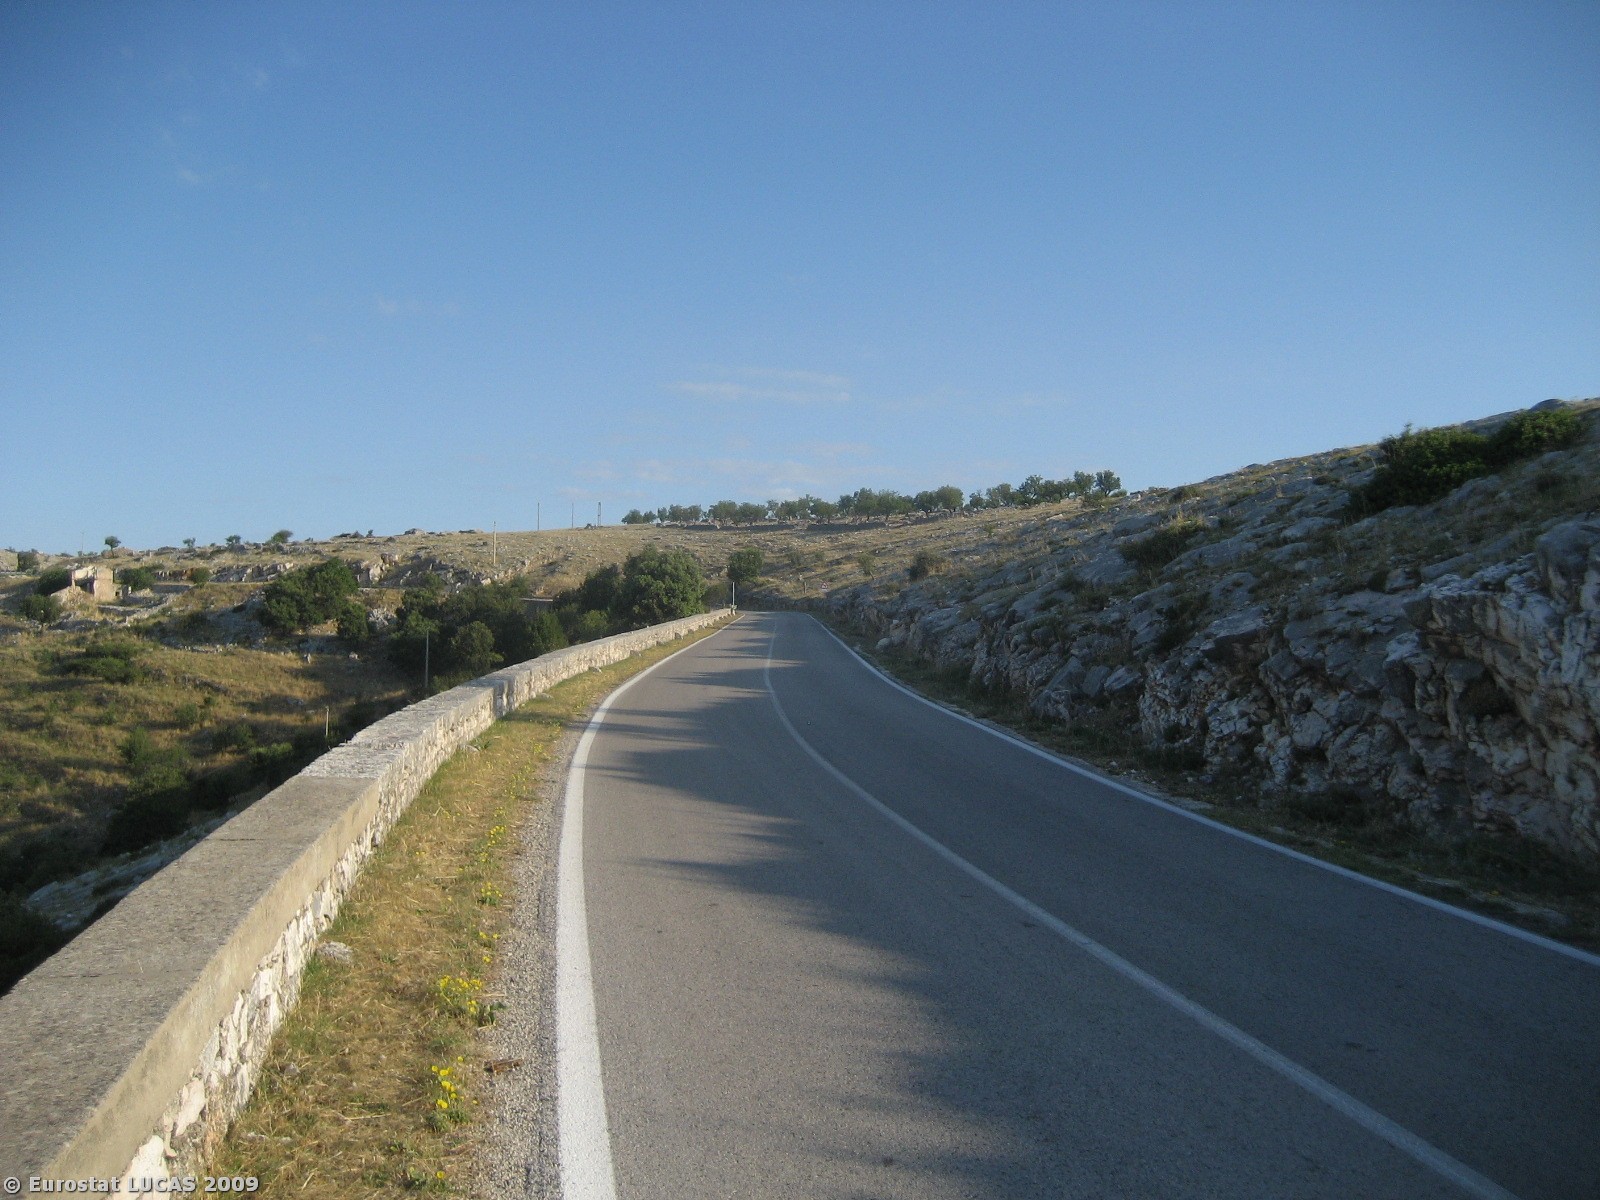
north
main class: Shrubland
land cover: Shrubland without tree cover
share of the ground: 50 - 75 %
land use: Agriculture (excluding fallow land and kitchen gardens)
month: July
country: IT
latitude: 41.6806
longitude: 15.6648
